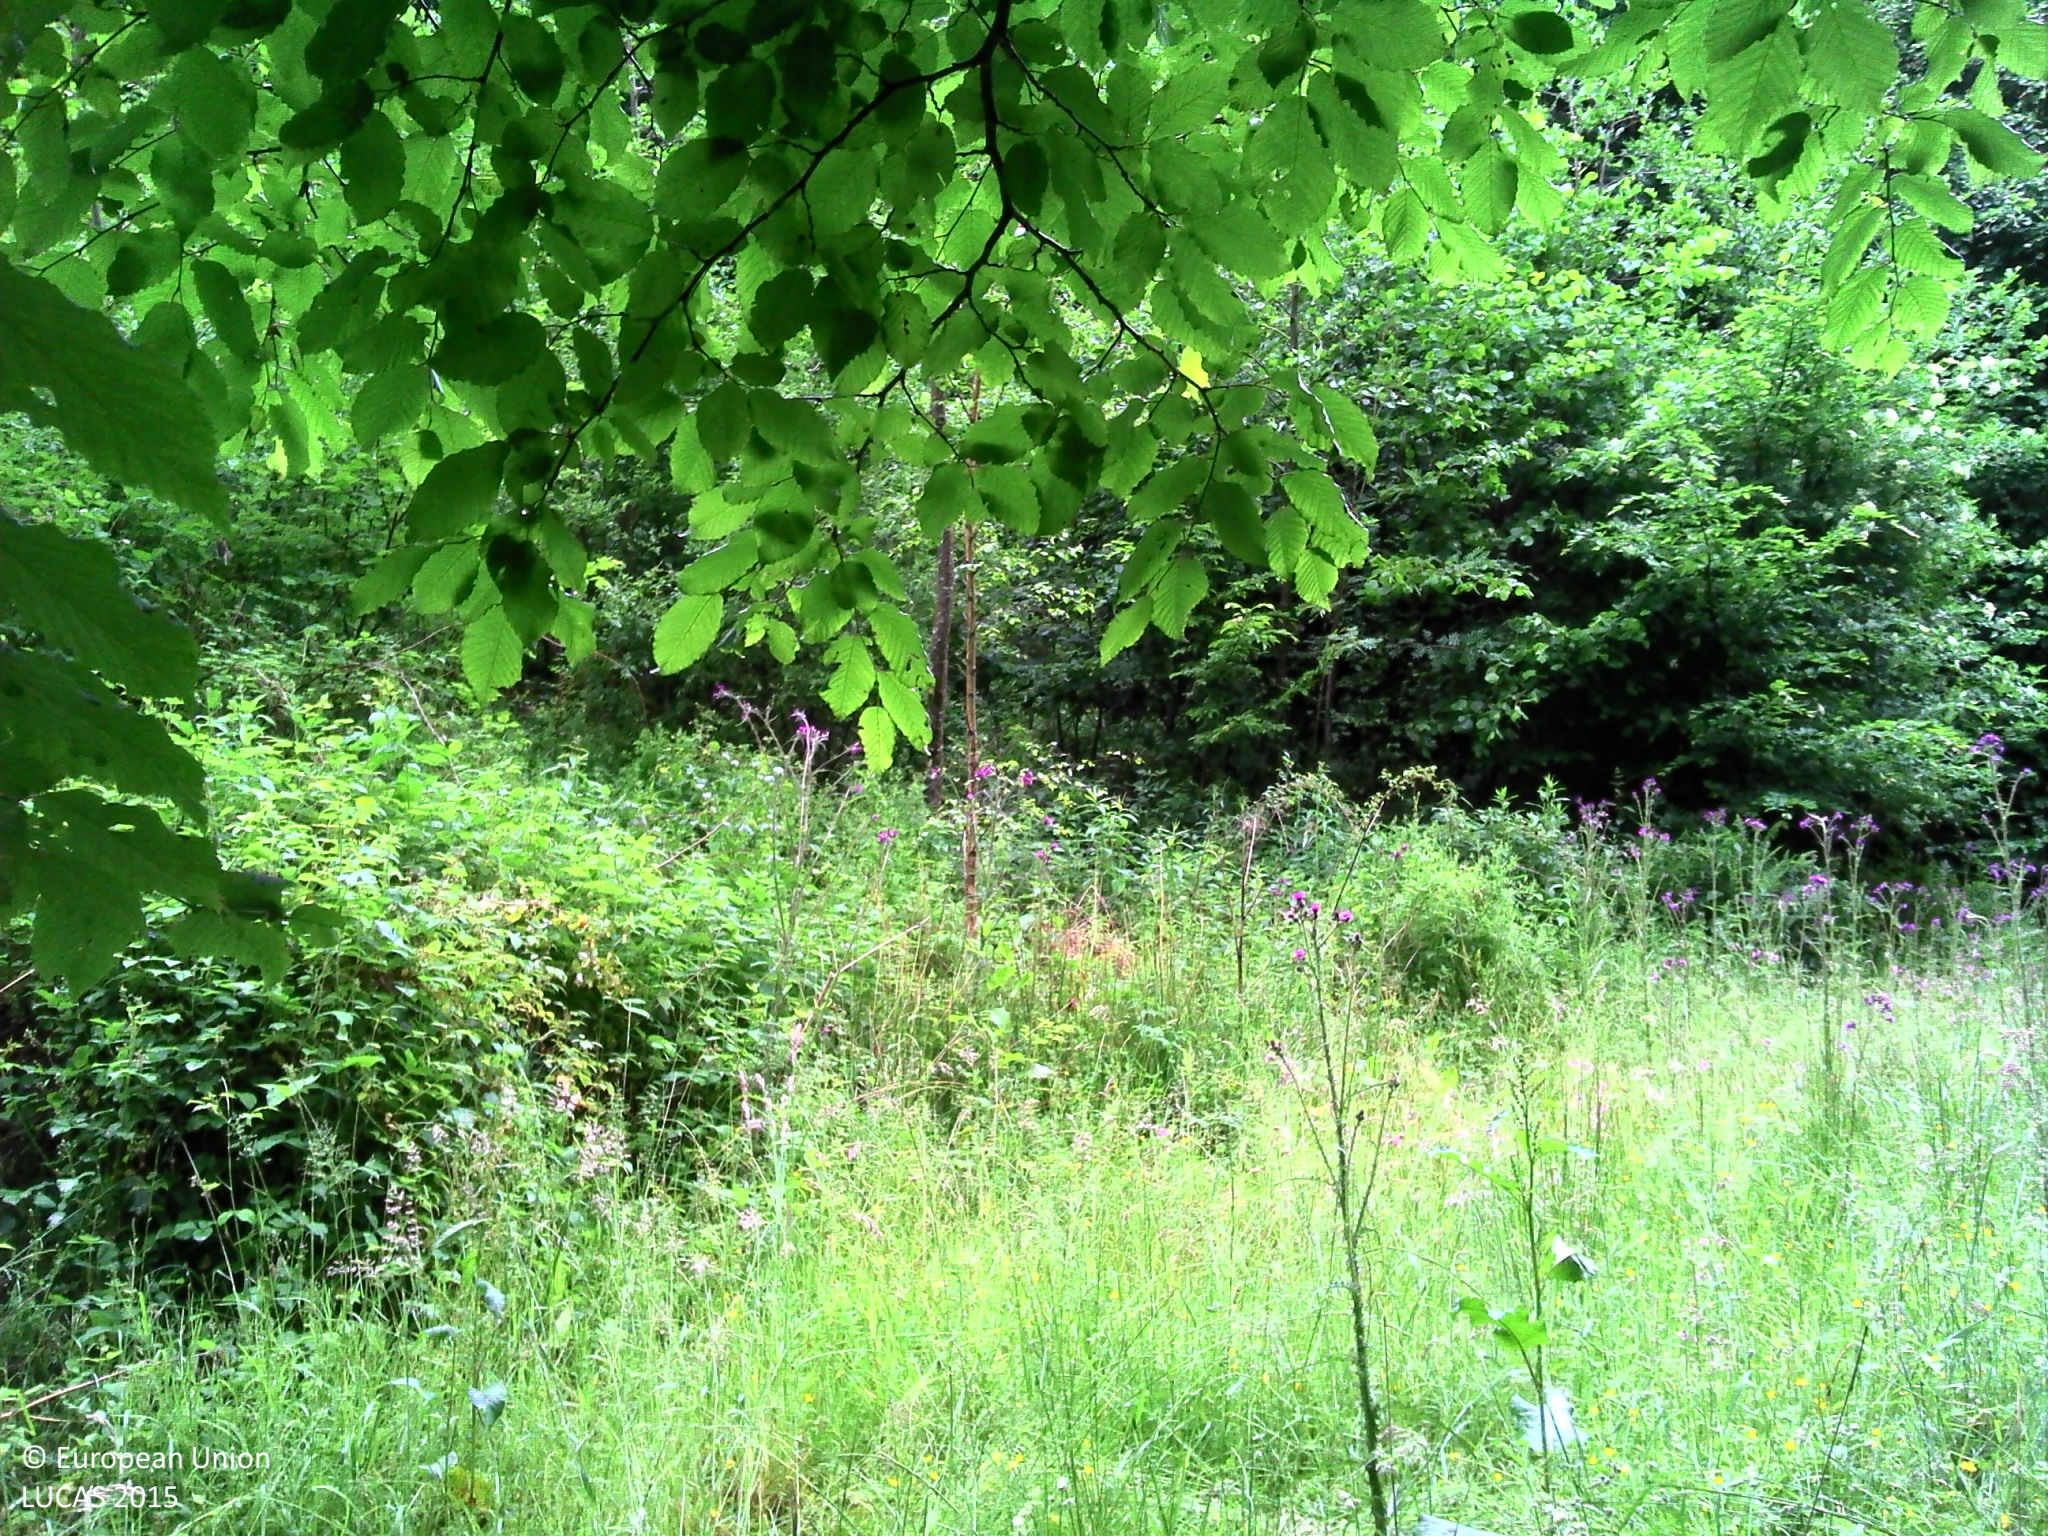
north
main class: Woodland
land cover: Broadleaved woodland
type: mesophytic deciduous forest
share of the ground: 50 - 75 %
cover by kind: broadleaved forest trees 60 %, shrubs 40 %
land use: Forestry
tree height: > 5 m
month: June
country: BE
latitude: 50.1677
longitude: 5.5043
